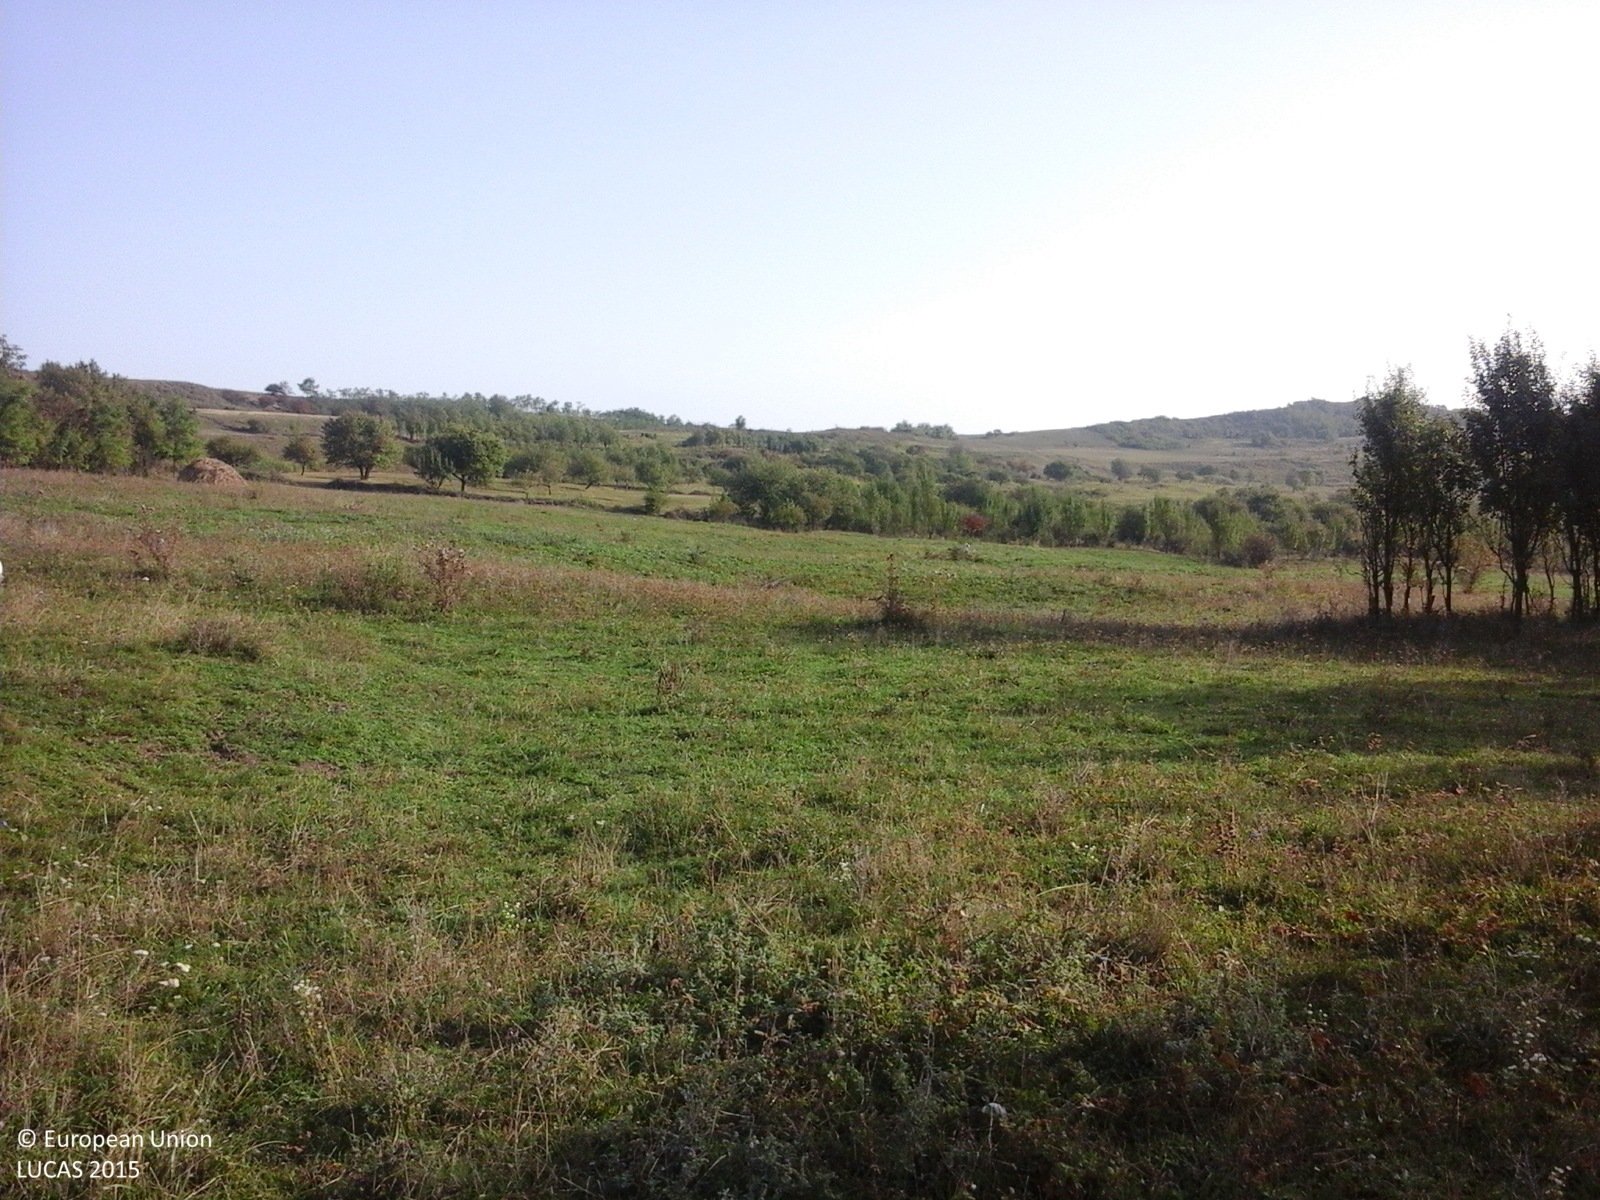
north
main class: Grassland
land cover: Grassland without tree/shrub cover
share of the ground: > 75 %
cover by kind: herbaceous plants 100 %
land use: Agriculture (excluding fallow land and kitchen gardens)
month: September
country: RO
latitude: 47.0320
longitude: 23.7209
